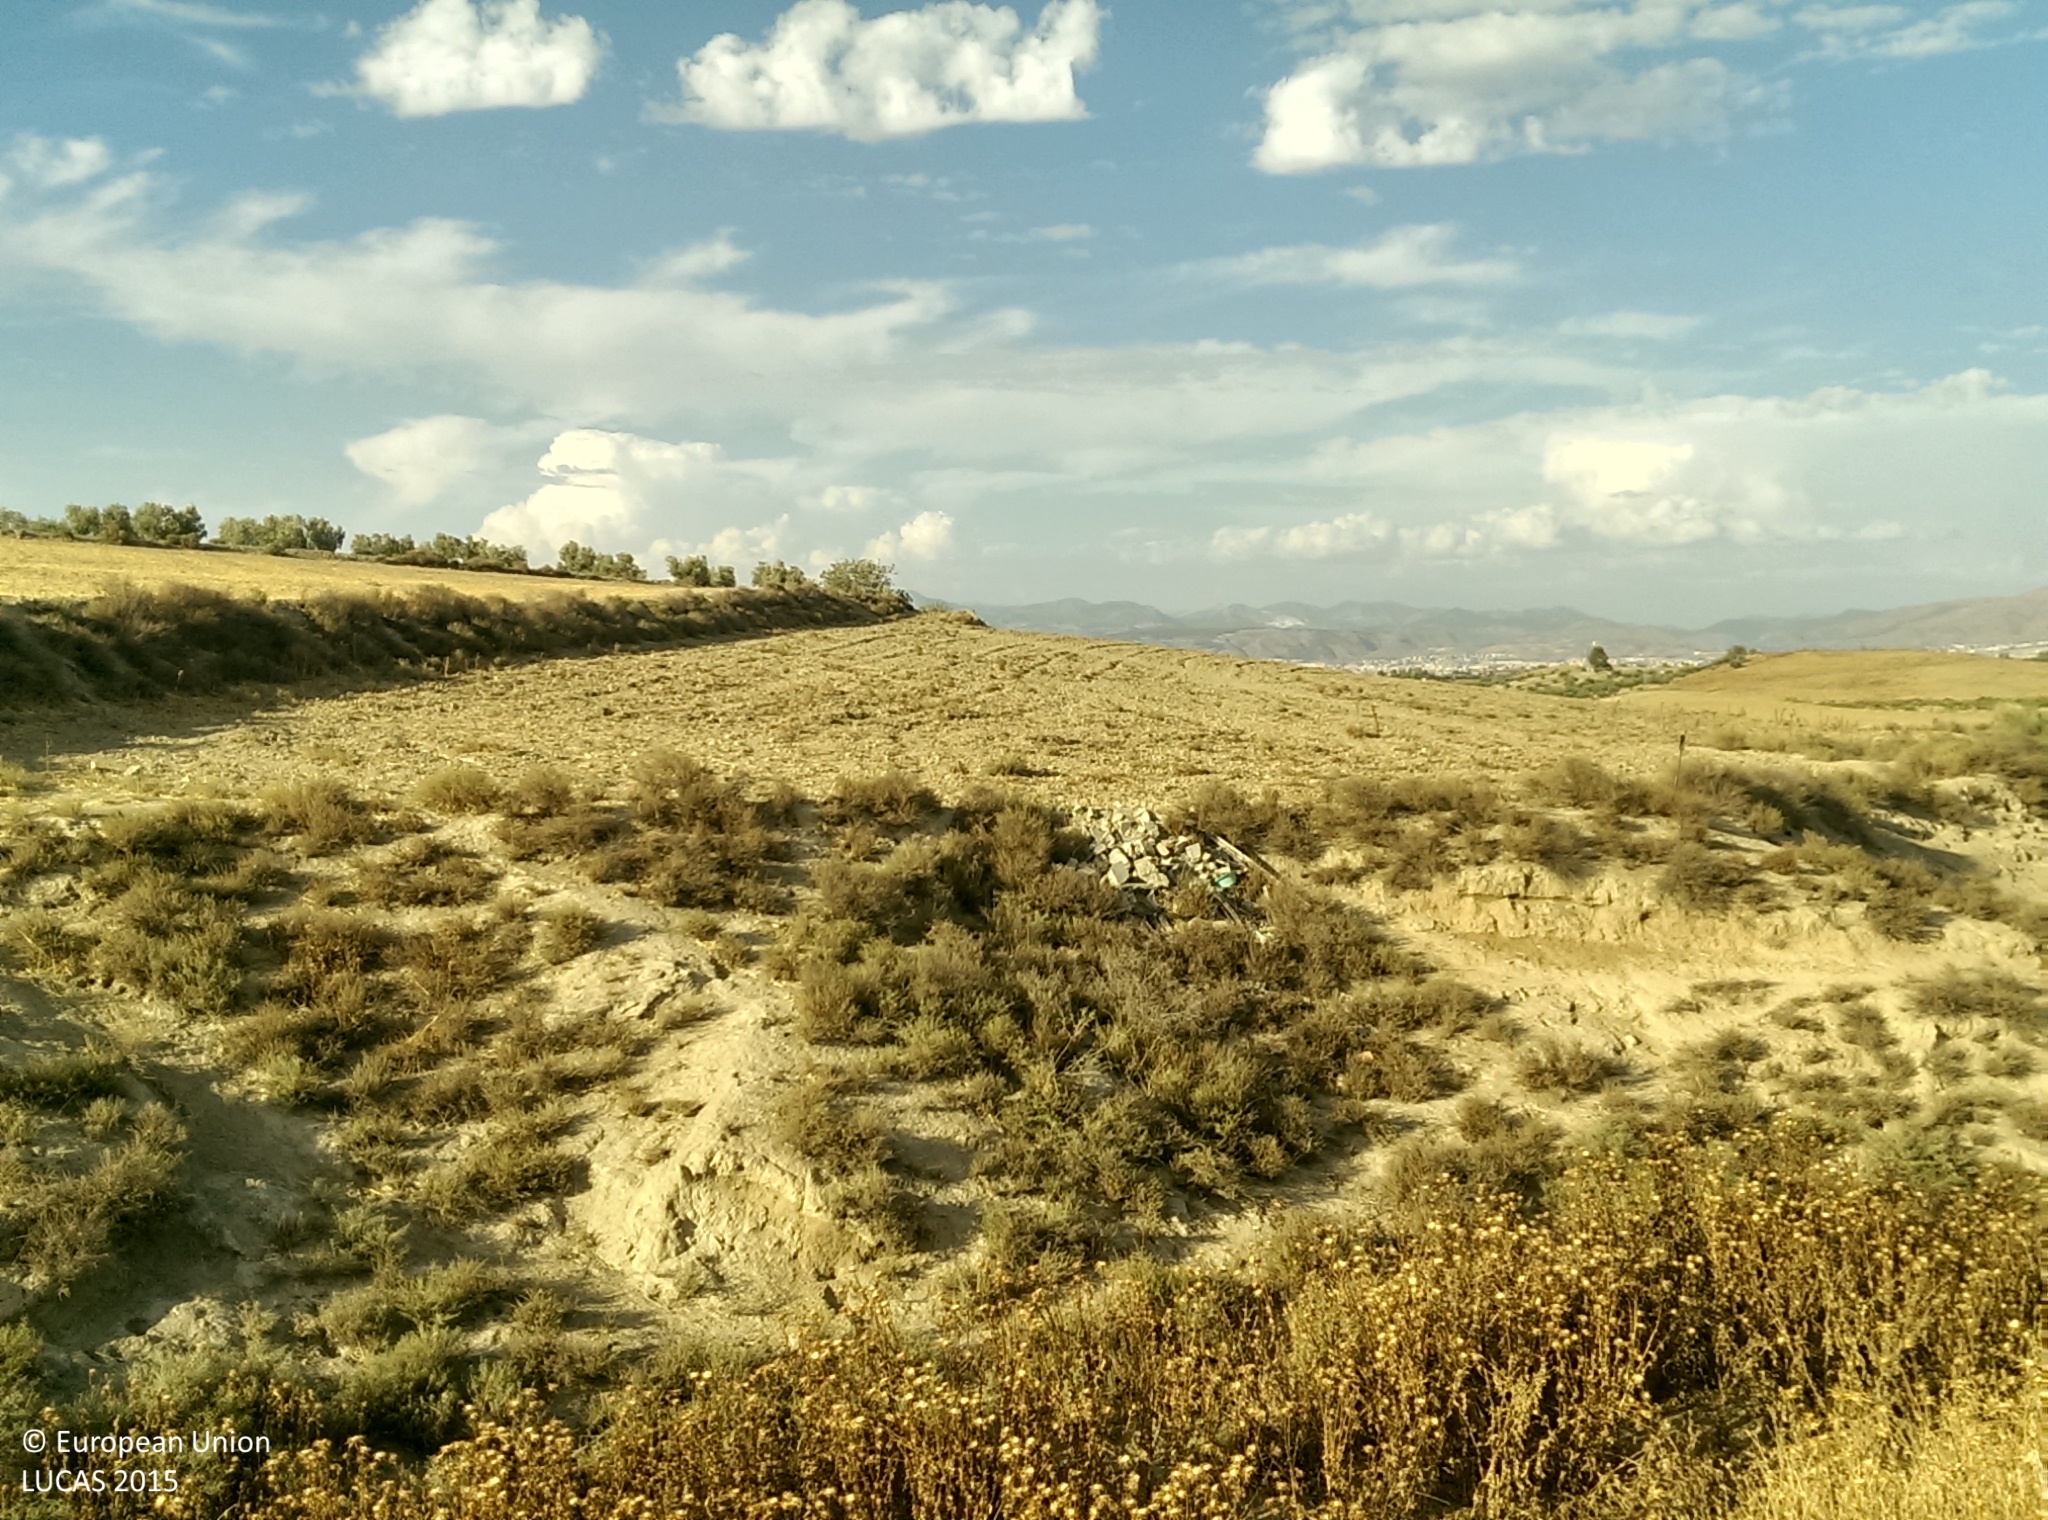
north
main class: Grassland
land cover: Spontaneously vegetated surfaces
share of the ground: 10 - 25 %
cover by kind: unconsolidated bare surface 90 %, herbaceous plants 10 %
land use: Agriculture (excluding fallow land and kitchen gardens)
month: August
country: ES
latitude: 37.0878
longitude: -3.6570
